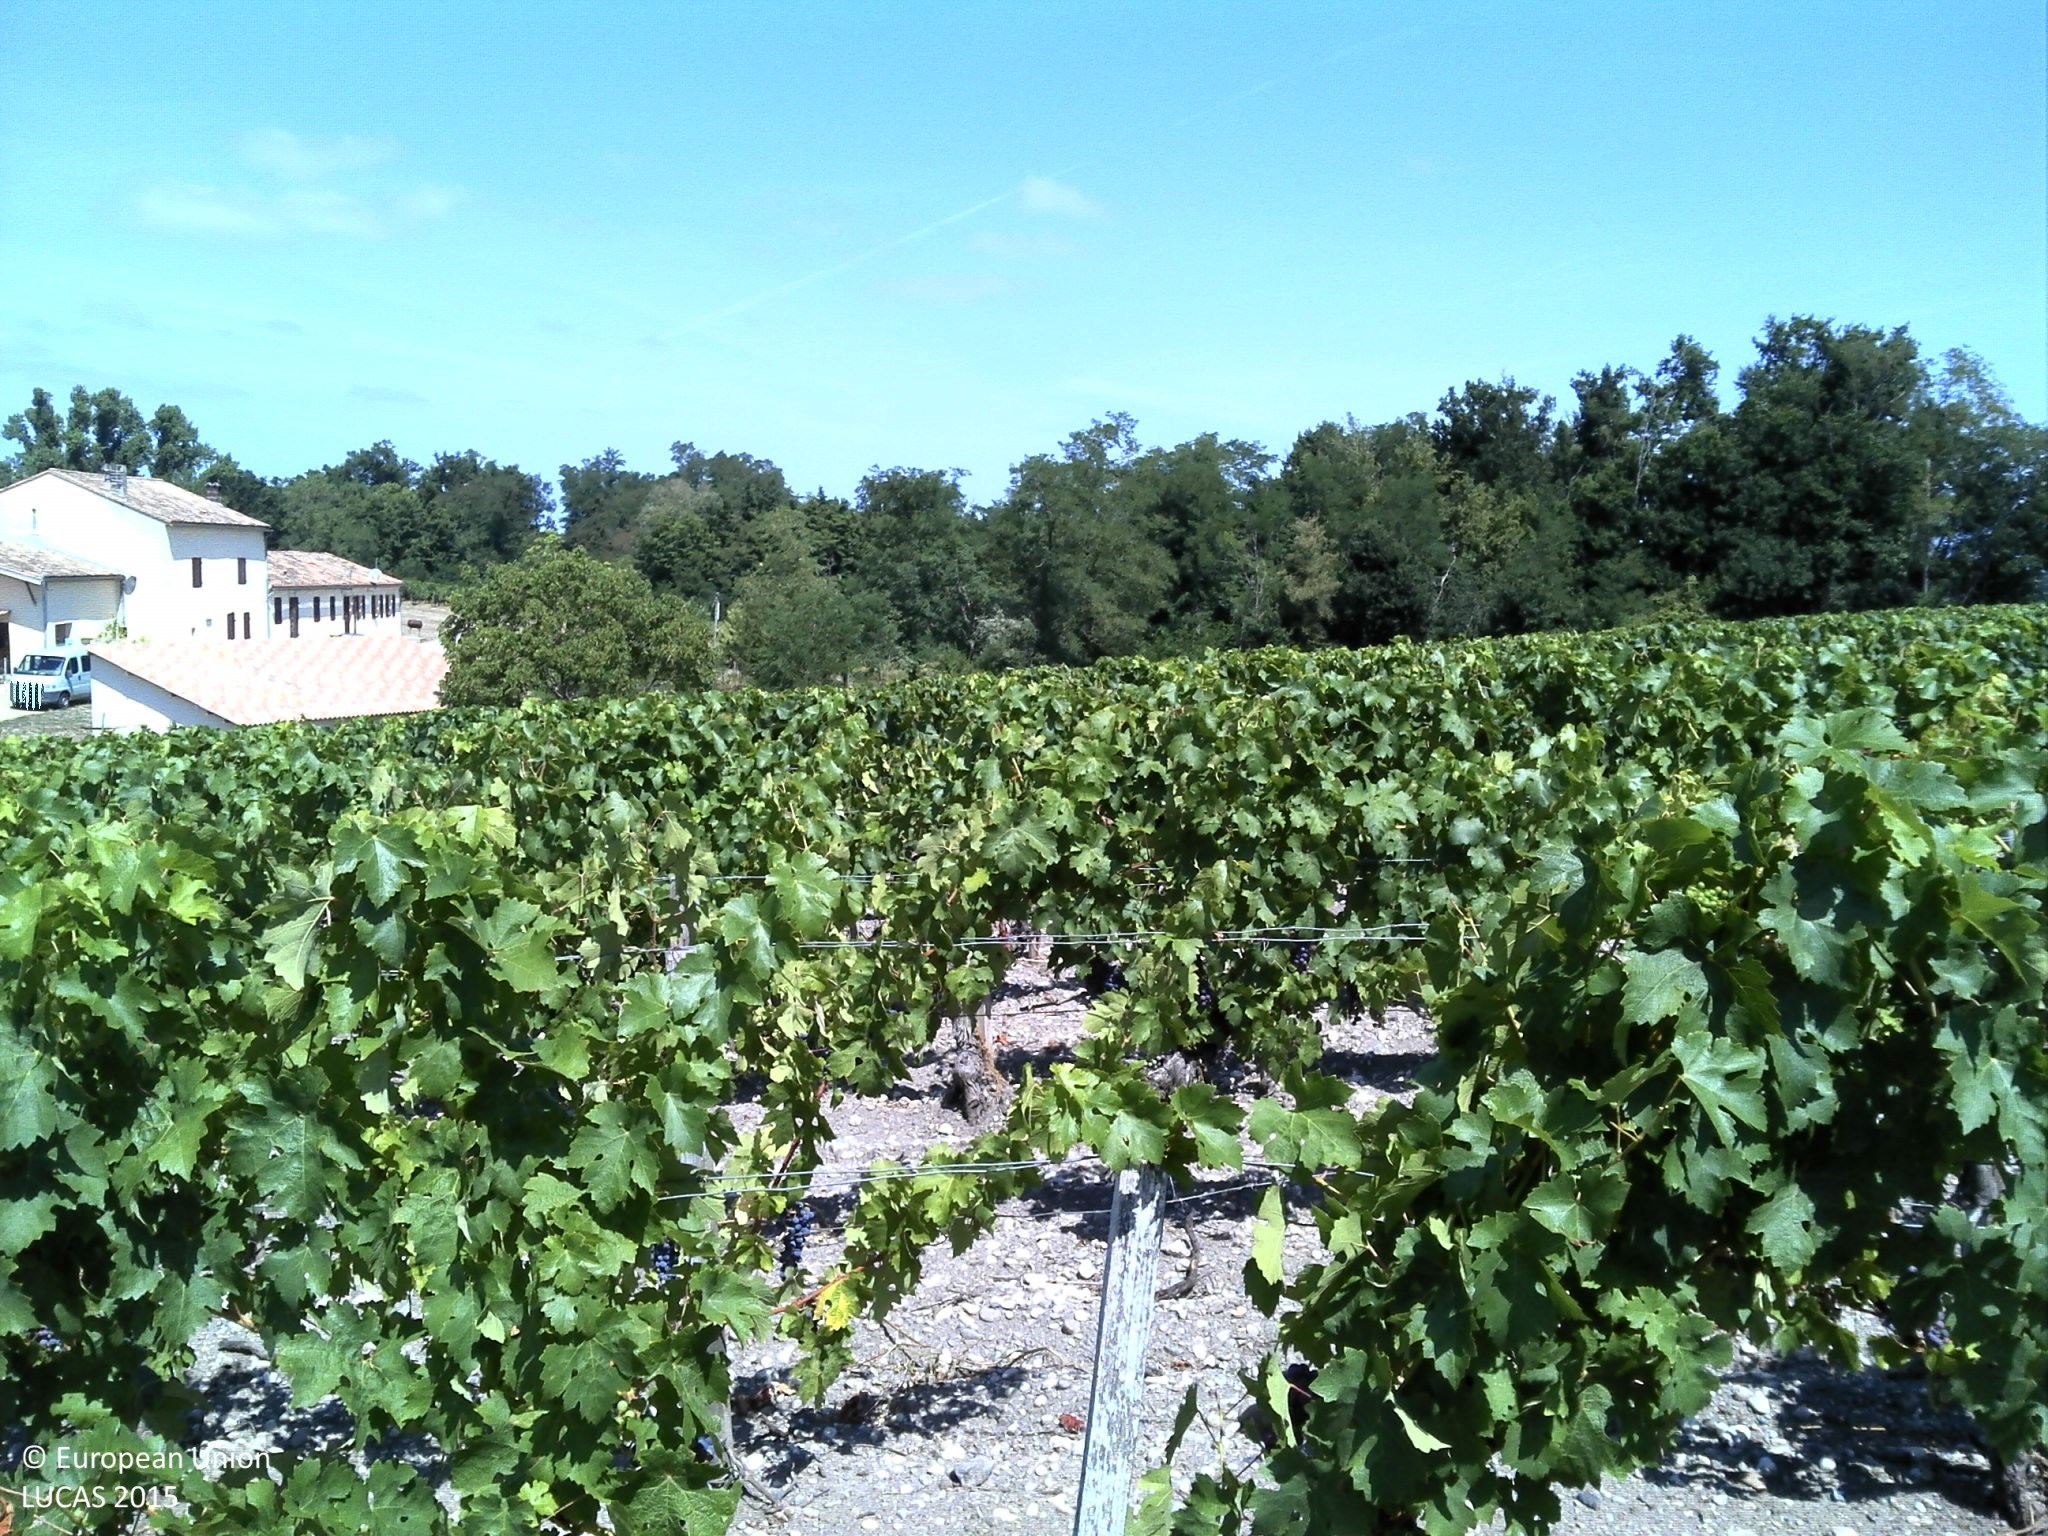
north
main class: Cropland
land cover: Vineyards
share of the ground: 25 - 50 %
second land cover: Other bare soil
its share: > 75 %
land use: Agriculture (excluding fallow land and kitchen gardens)
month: August
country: FR
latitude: 45.1873
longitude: -0.7772
